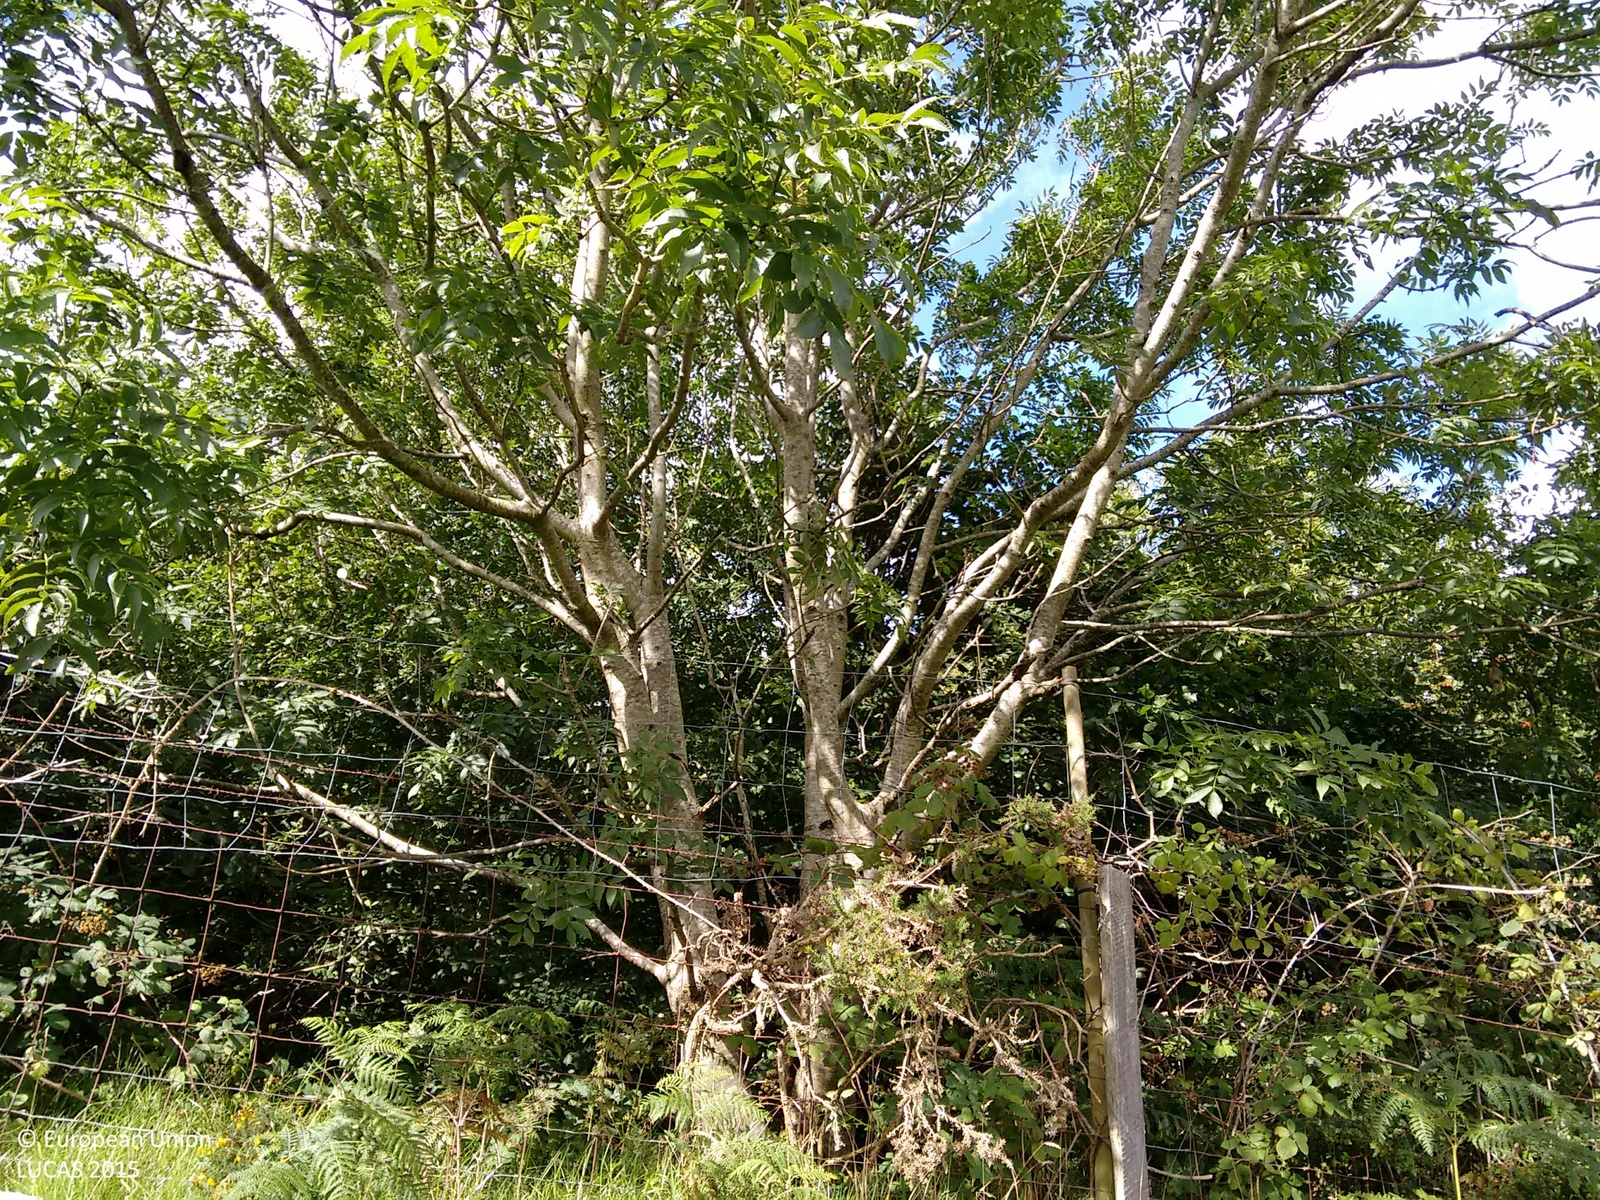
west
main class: Woodland
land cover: Broadleaved woodland
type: mesophytic deciduous forest
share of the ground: > 75 %
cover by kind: broadleaved forest trees 80 %, shrubs 20 %
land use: Semi-natural and natural areas not in use
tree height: > 5 m
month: August
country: GB
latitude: 52.0009
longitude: -4.8695
